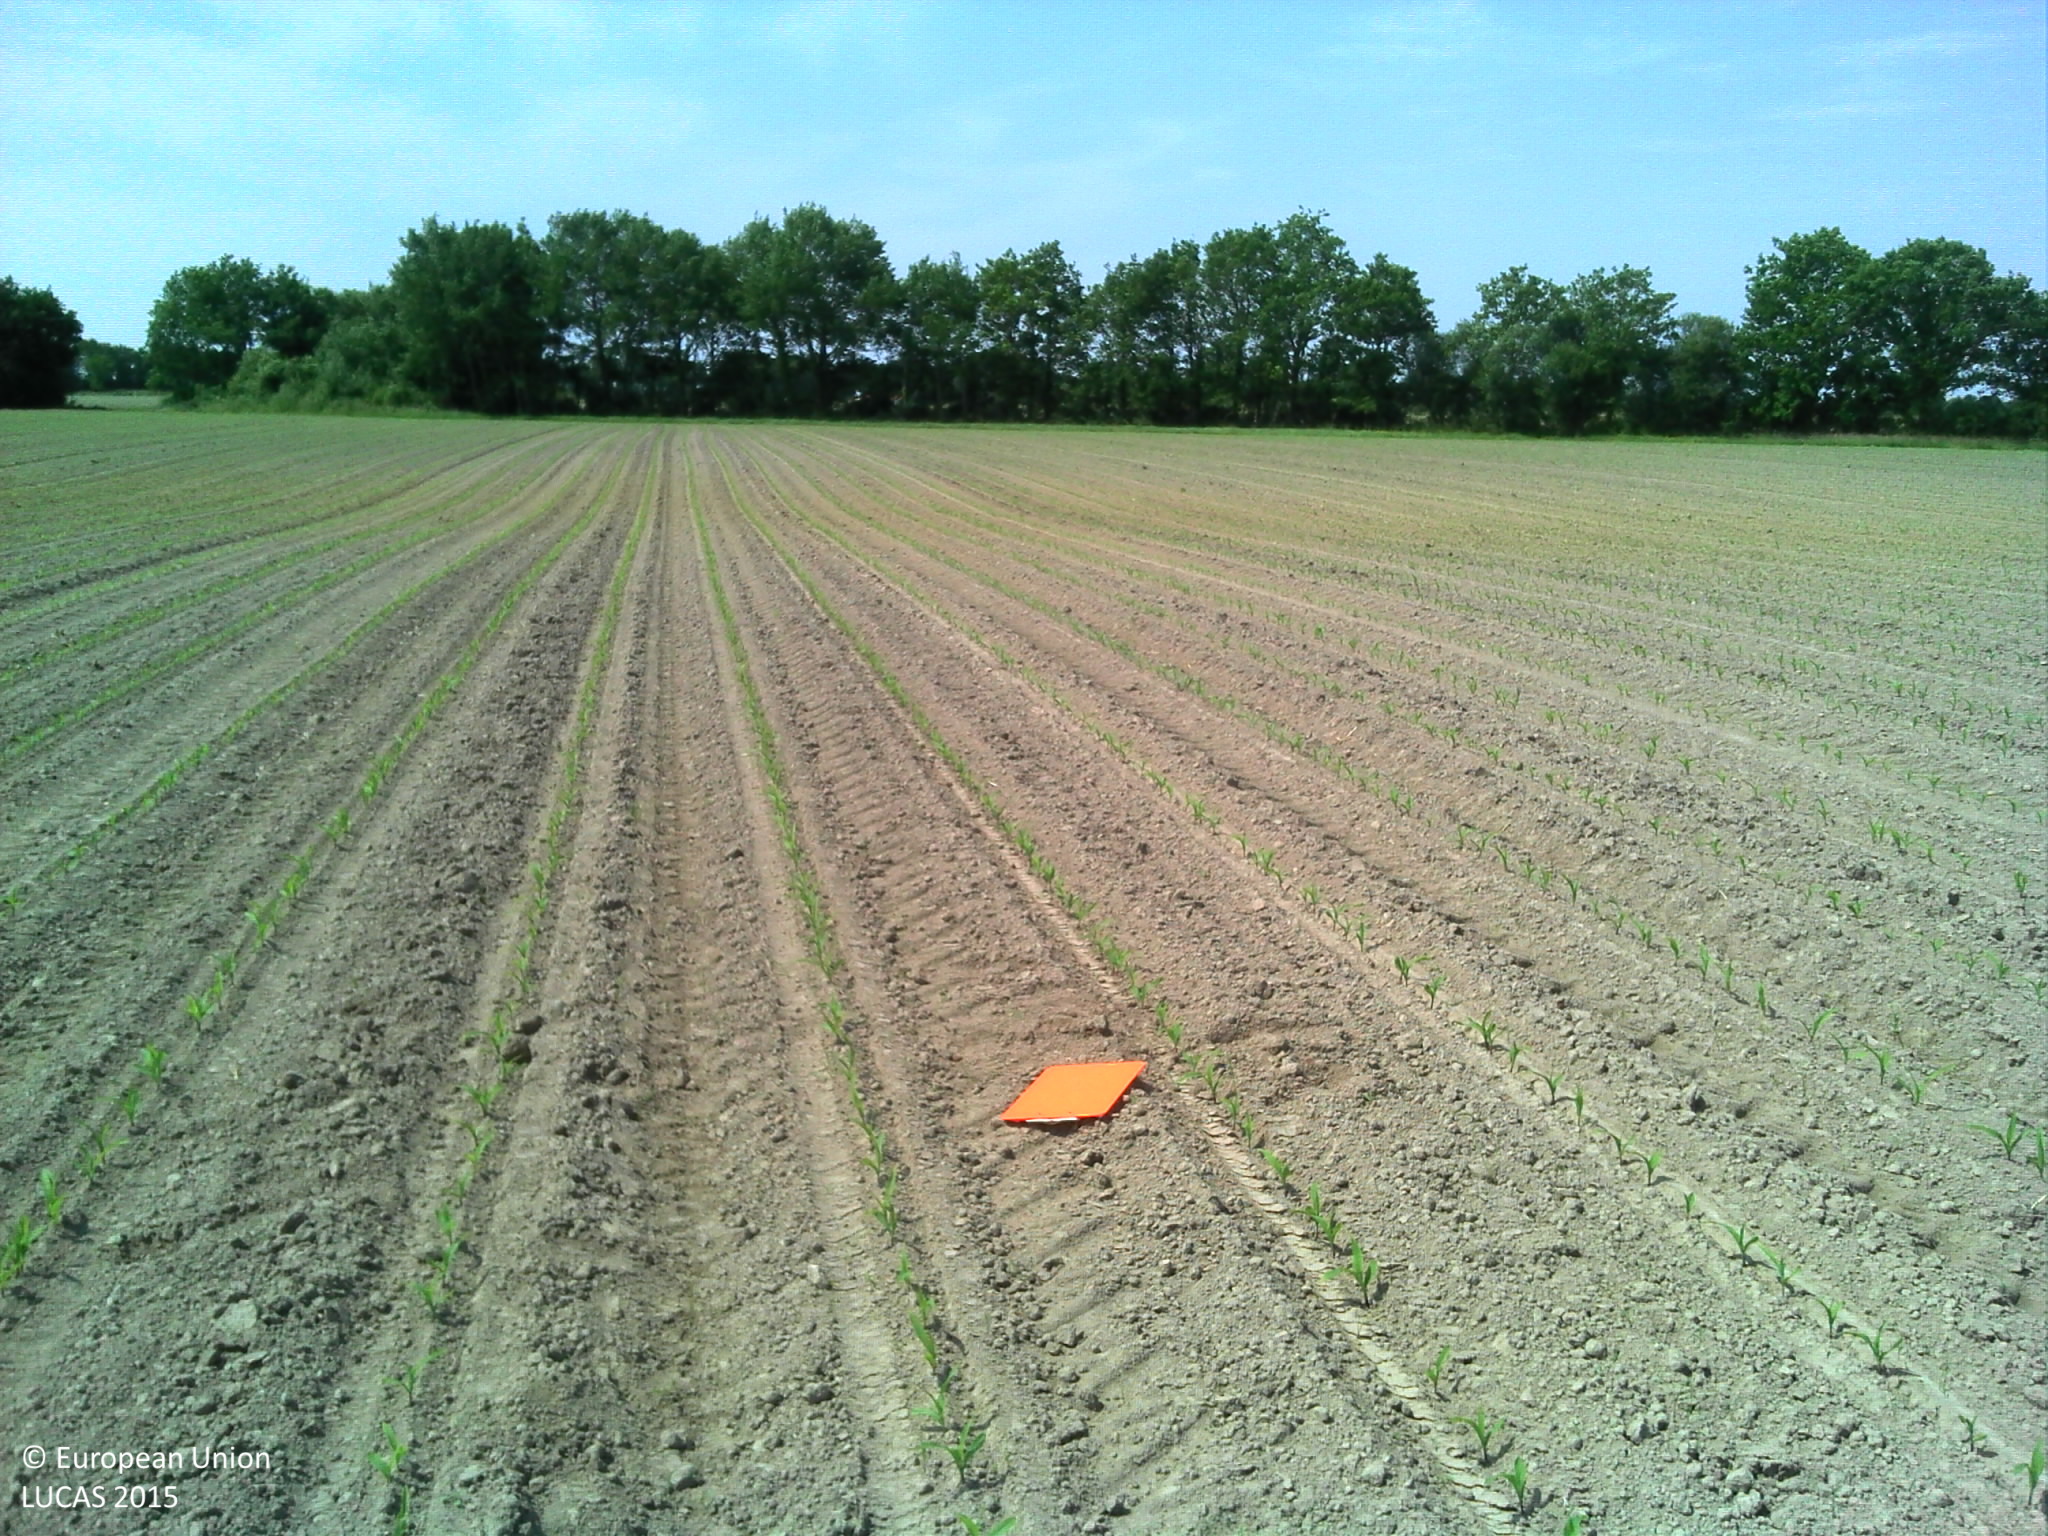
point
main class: Cropland
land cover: Maize
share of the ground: < 10 %
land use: Agriculture (excluding fallow land and kitchen gardens)
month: June
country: FR
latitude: 46.8318
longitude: -1.7235
